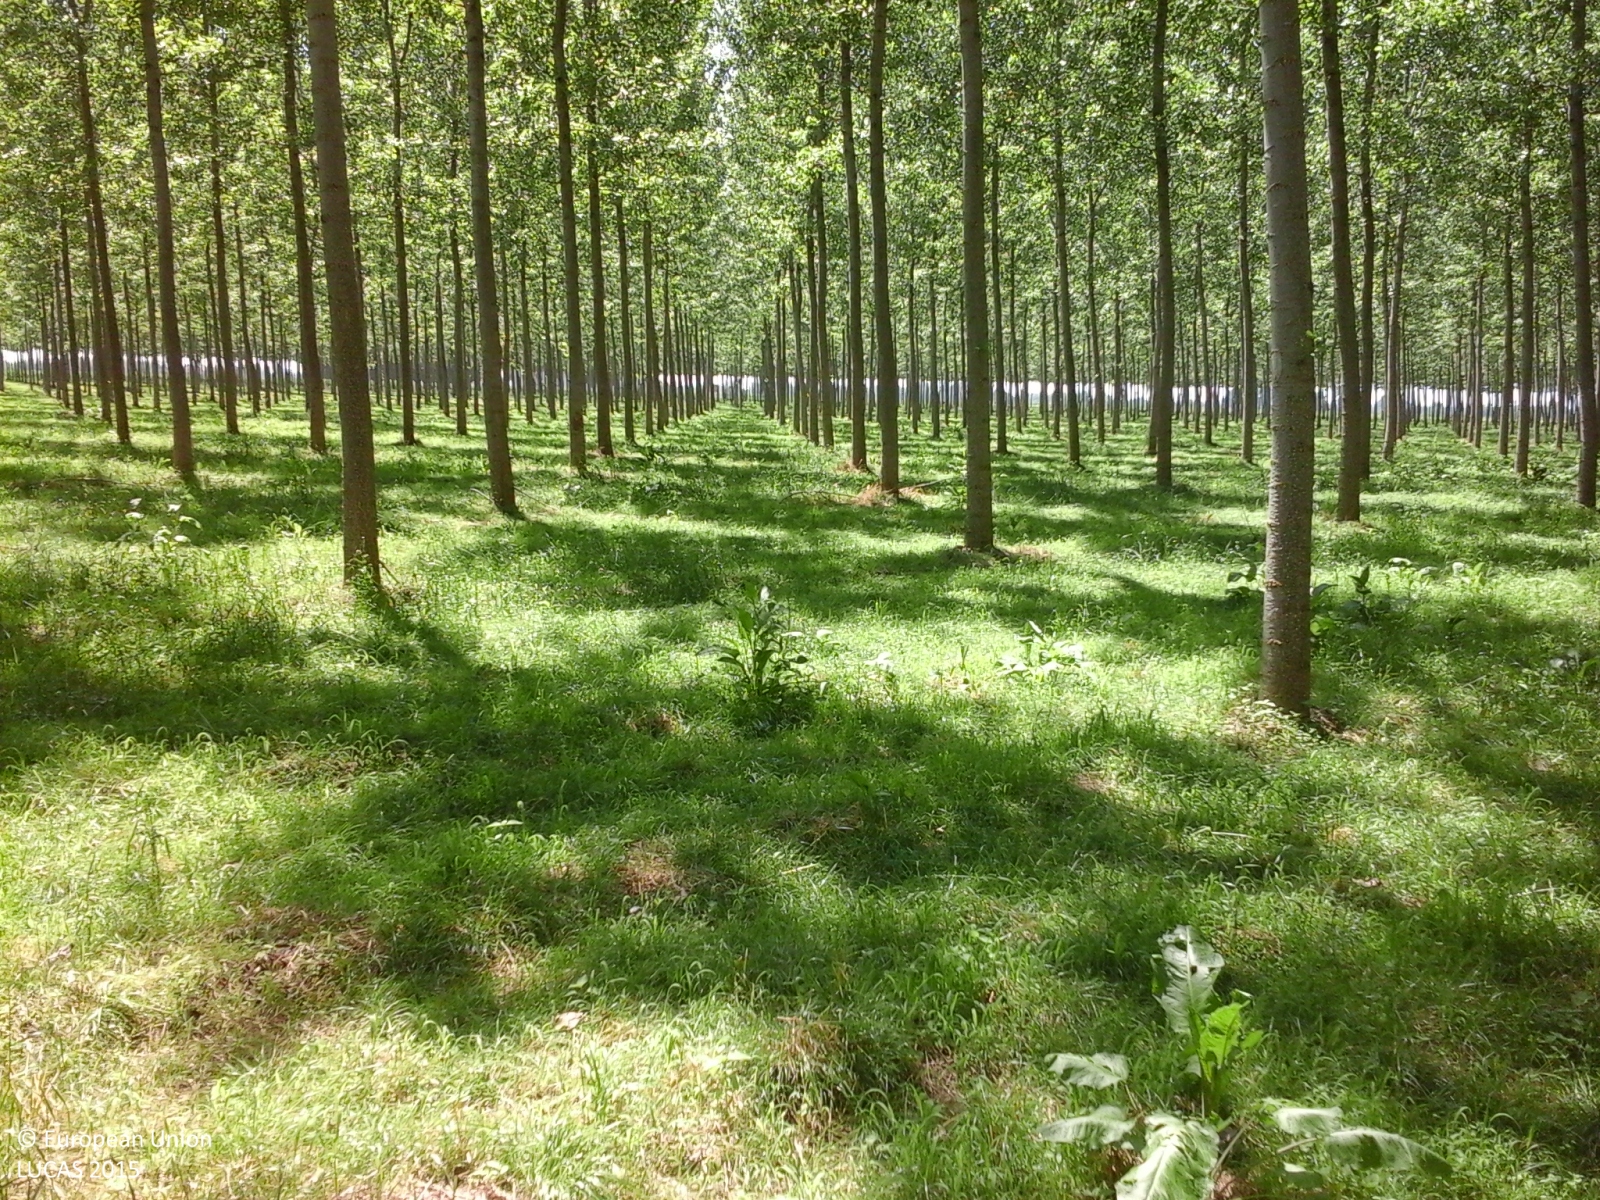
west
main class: Woodland
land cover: Broadleaved woodland
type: non-riverine alder, birch or aspen forest
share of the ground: > 75 %
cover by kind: broadleaved forest trees 100 %
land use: Forestry
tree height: > 5 m
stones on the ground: < 10 %
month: June
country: IT
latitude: 44.8857
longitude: 7.7632
